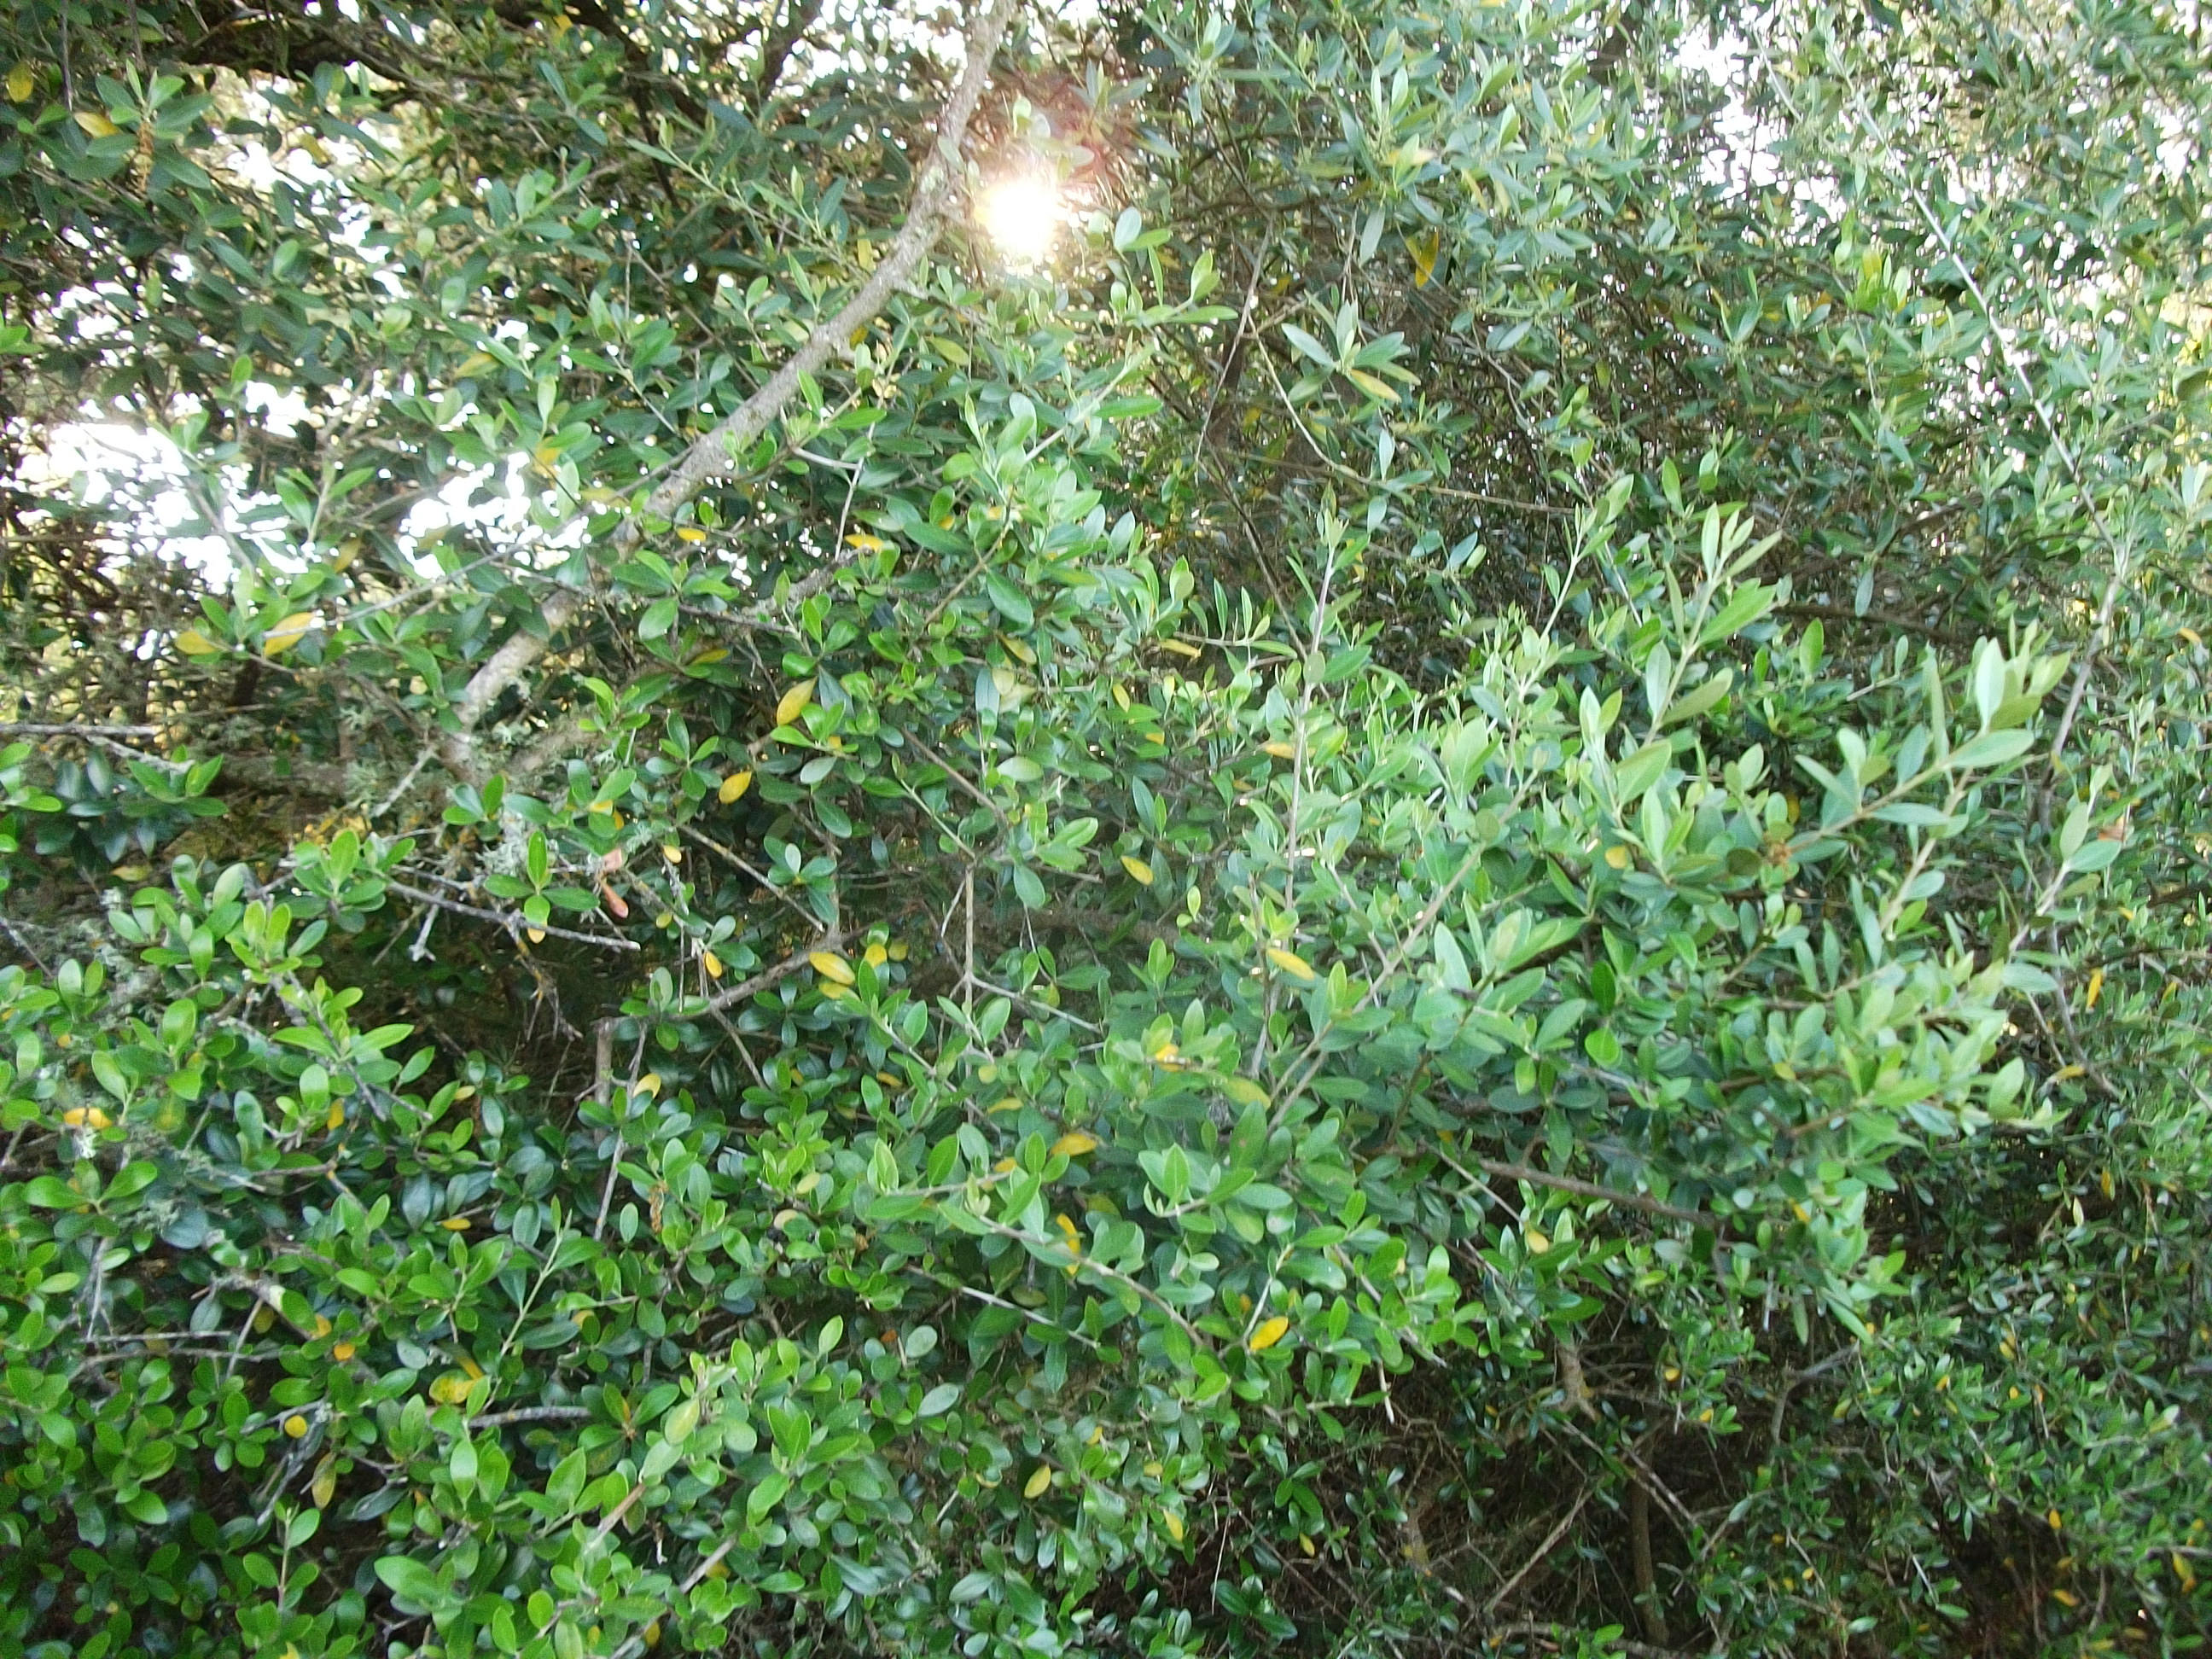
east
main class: Woodland
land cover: Broadleaved woodland
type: broadleaved evergreen forest
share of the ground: 25 - 50 %
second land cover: Spontaneously vegetated surfaces
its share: 25 - 50 %
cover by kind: broadleaved forest trees 40 %, shrubs 30 %, herbaceous plants 30 %
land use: Forestry
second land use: Agriculture (excluding fallow land and kitchen gardens)
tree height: > 5 m
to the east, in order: Broadleaved woodland; Spontaneously vegetated surfaces; Rock outcrops; Broadleaved woodland; Dry stone walls; Fences; Broadleaved woodland; Rock outcrops; Broadleaved woodland
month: April
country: ES
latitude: 38.0425
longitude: -6.7427
